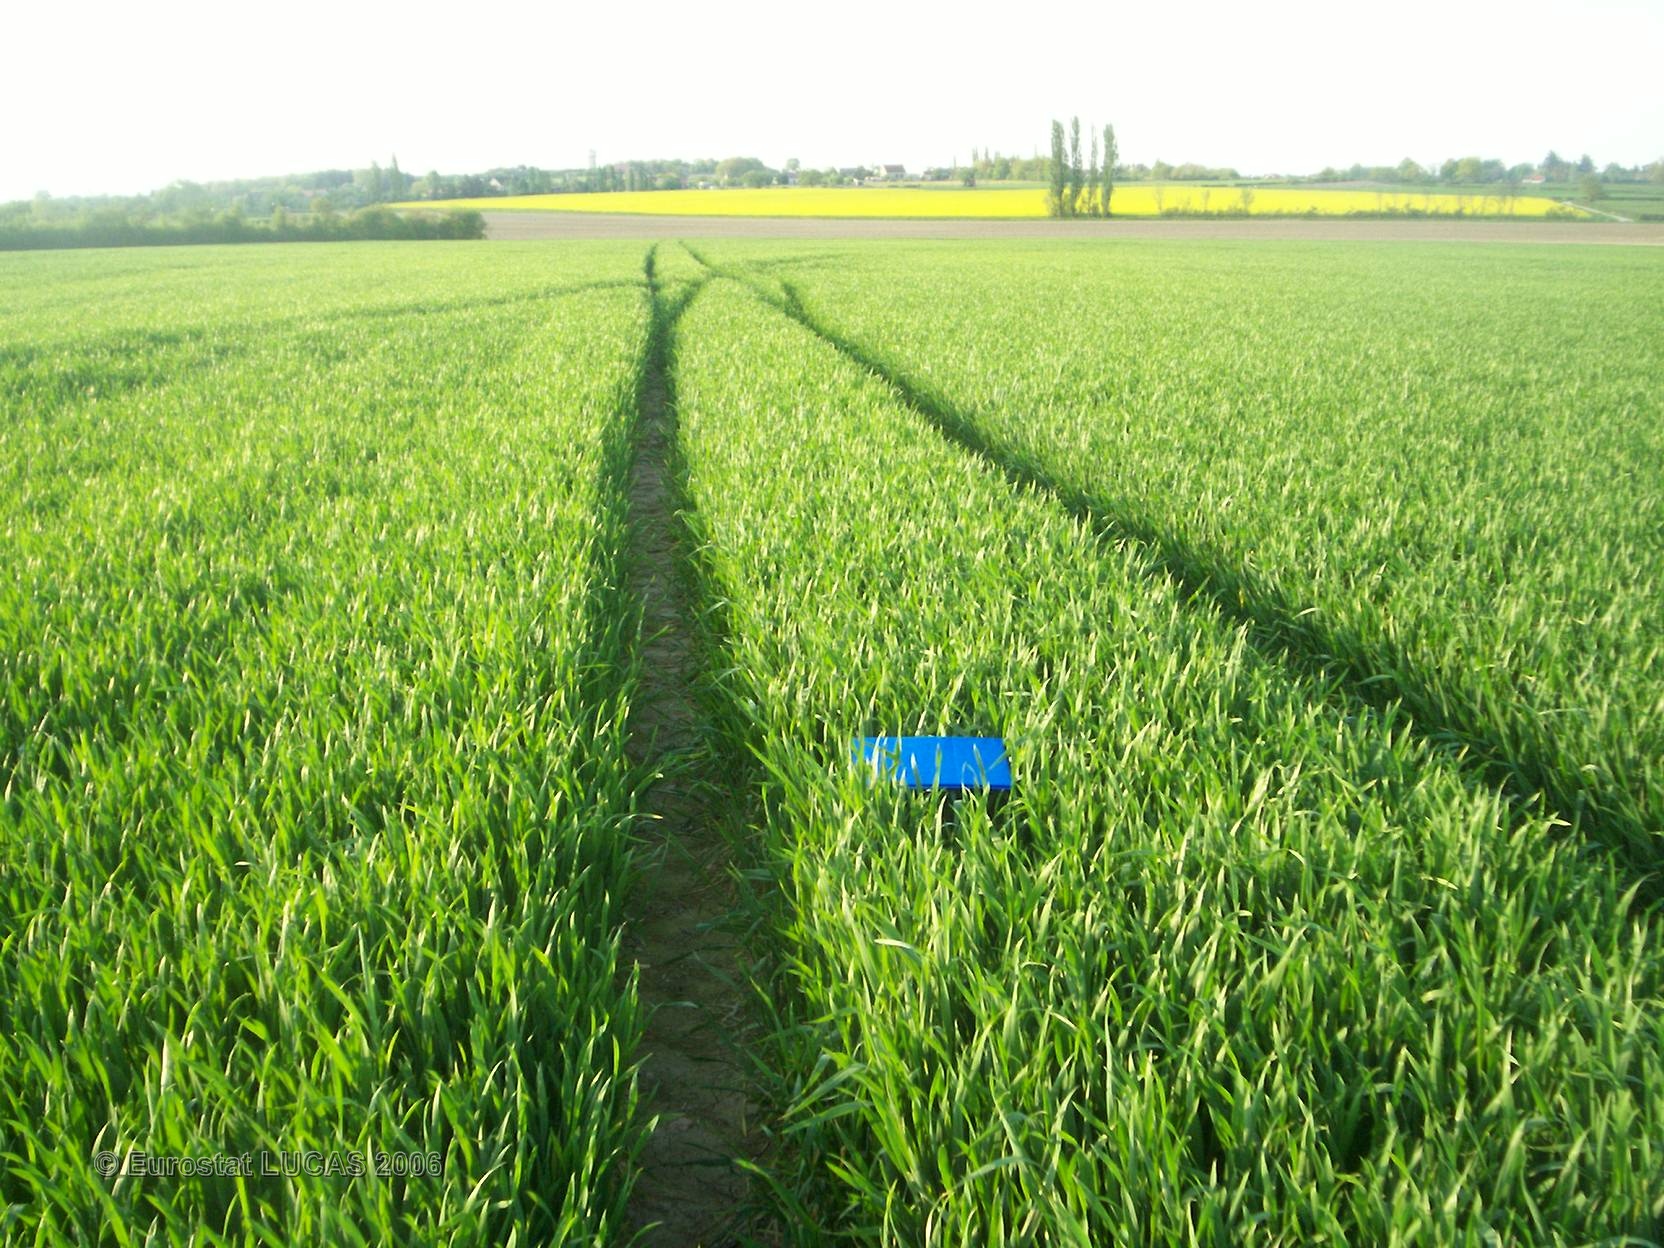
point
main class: Cropland
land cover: Barley
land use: Agriculture (excluding fallow land and kitchen gardens)
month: May
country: FR
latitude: 46.2213
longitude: 3.1404
